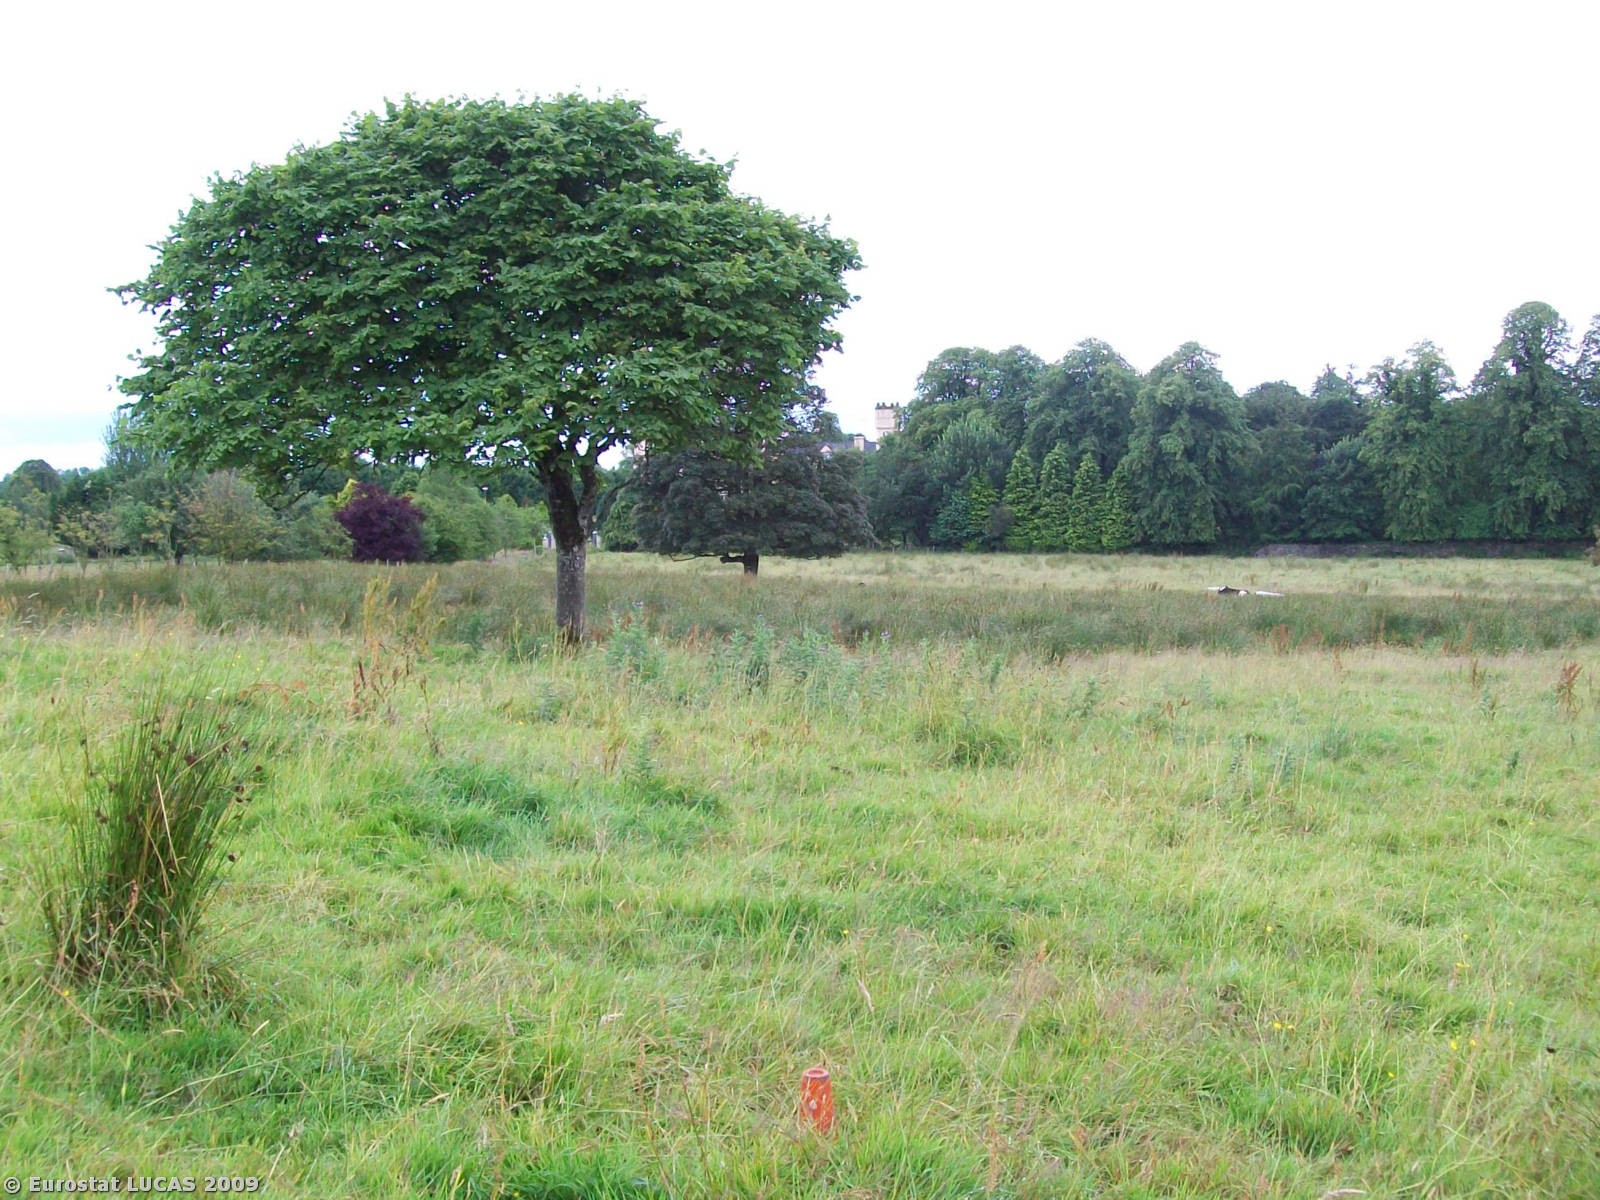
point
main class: Grassland
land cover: Grassland without tree/shrub cover
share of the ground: > 75 %
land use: Agriculture (excluding fallow land and kitchen gardens)
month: July
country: IE
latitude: 53.6945
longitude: -8.9757
